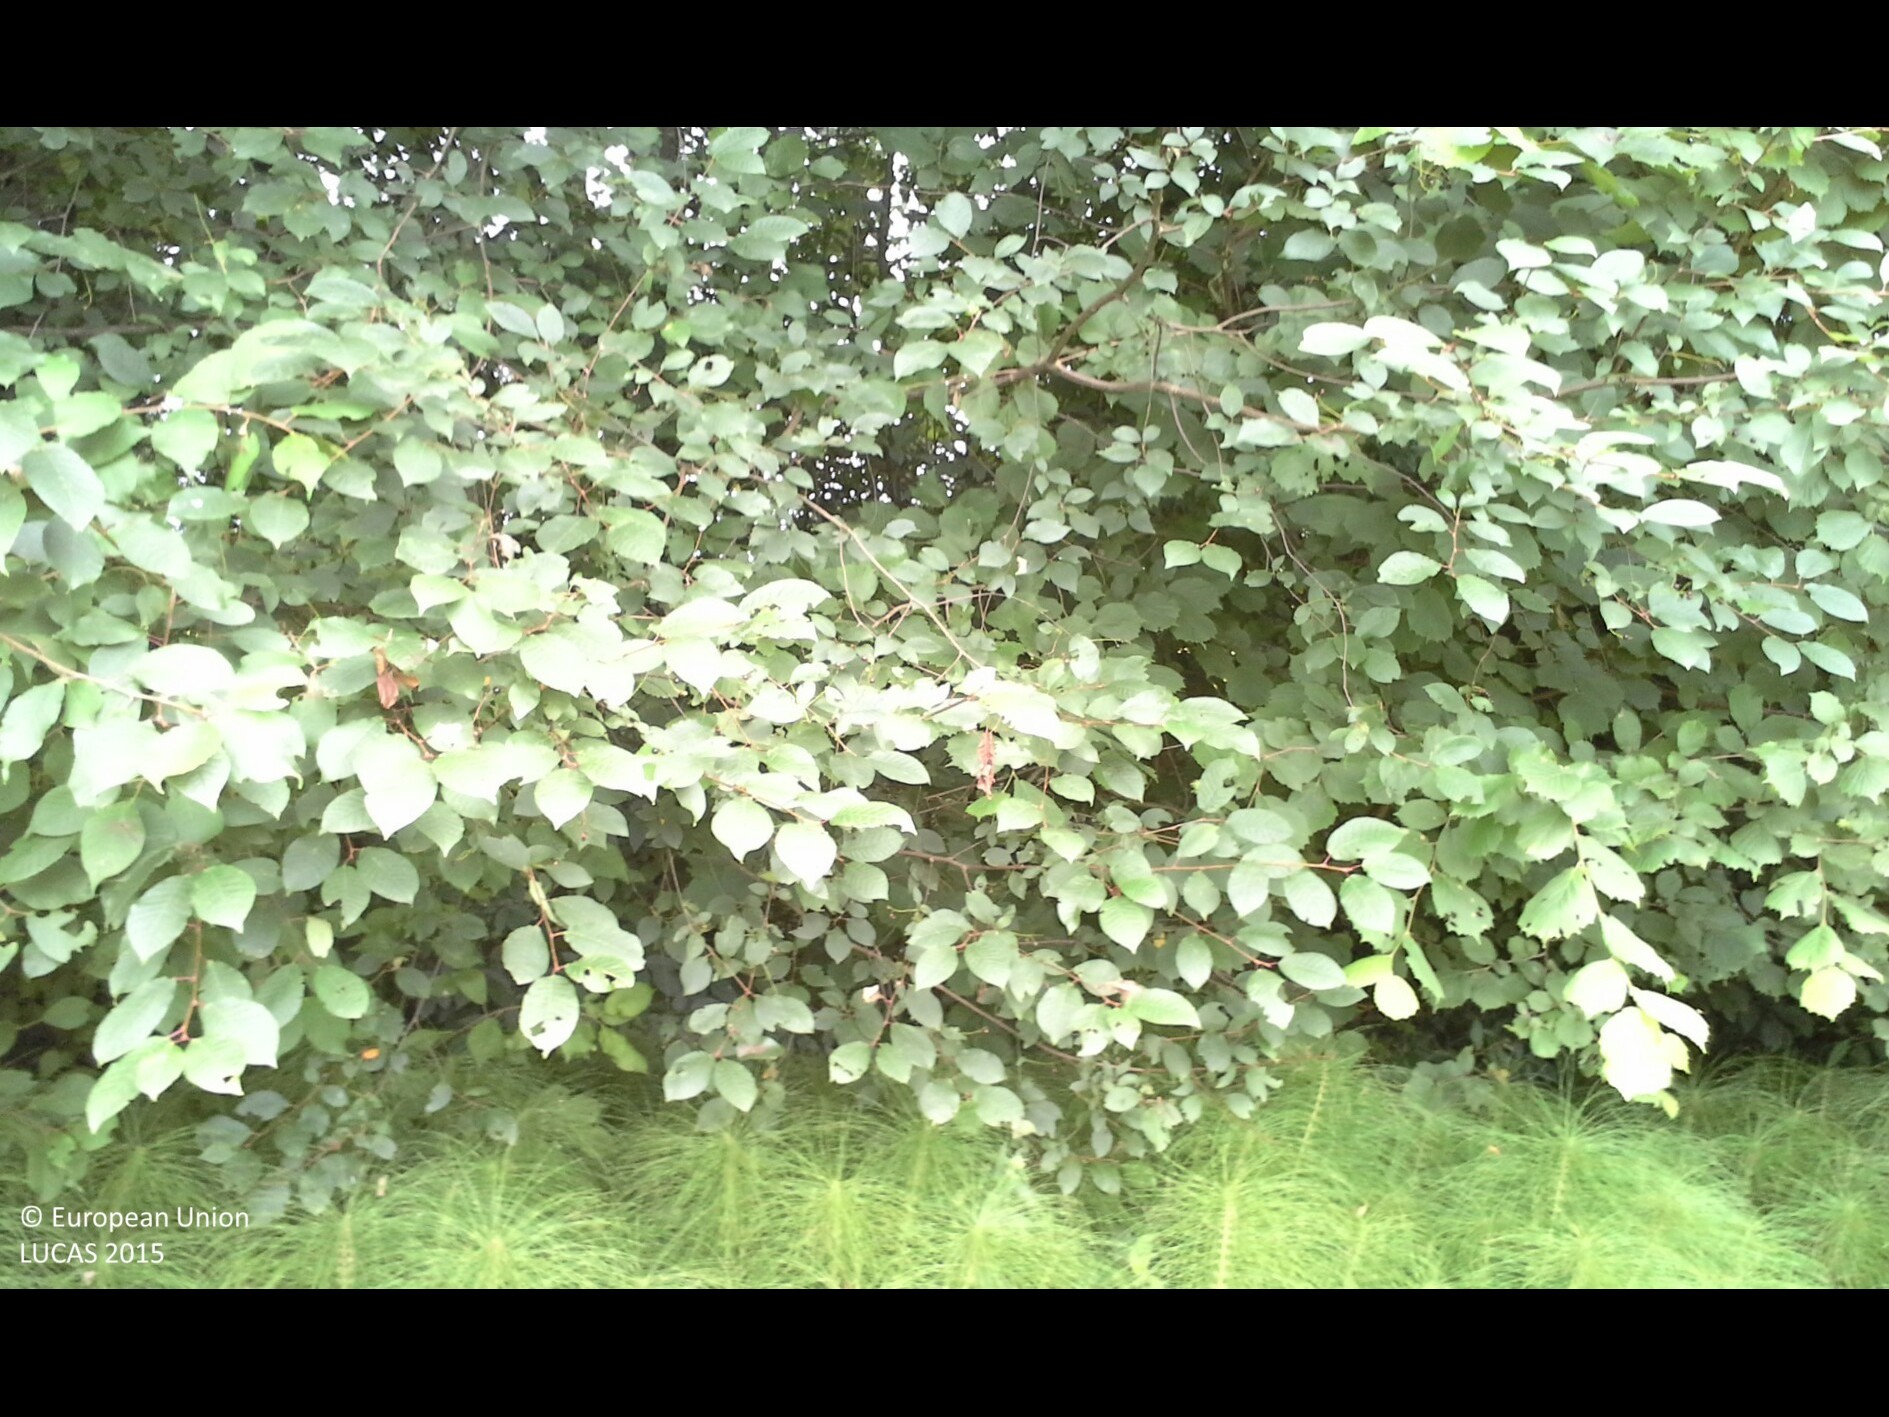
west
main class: Grassland
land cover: Grassland without tree/shrub cover
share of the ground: > 75 %
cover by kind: herbaceous plants 100 %
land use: Agriculture (excluding fallow land and kitchen gardens)
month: June
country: AT
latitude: 48.0733
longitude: 14.6039
